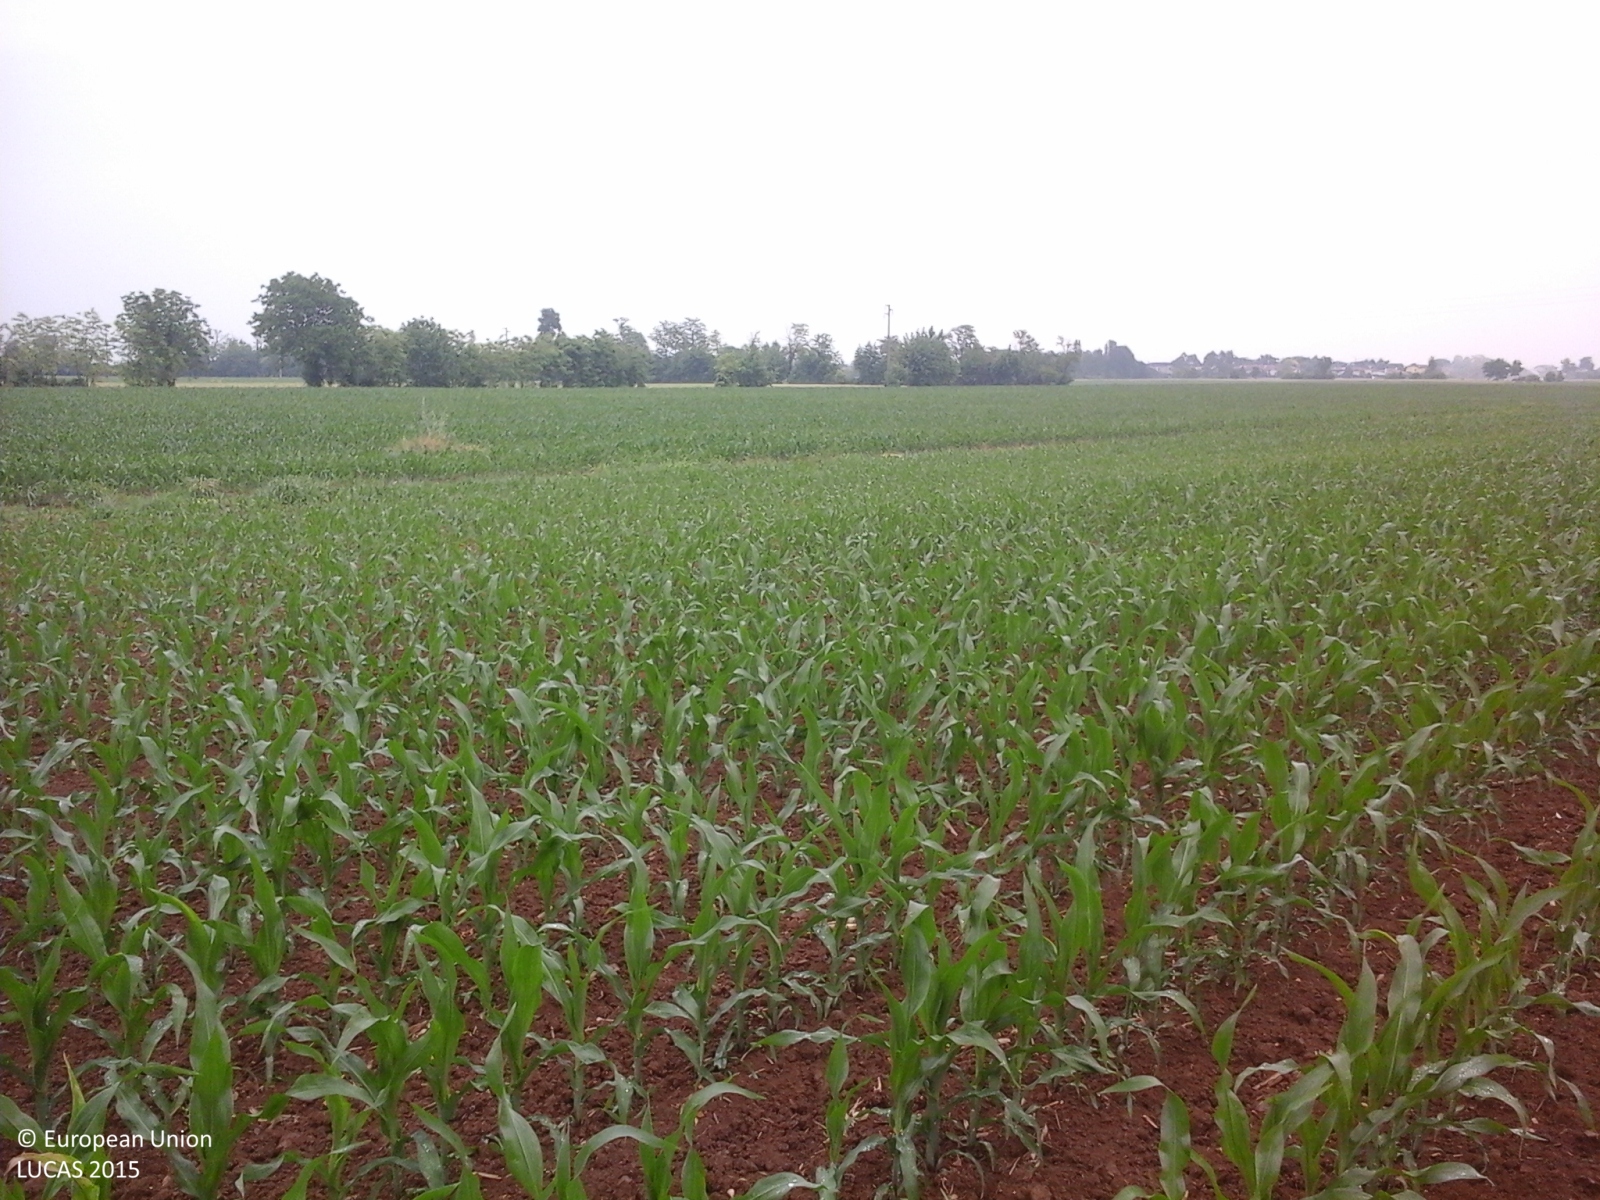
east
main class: Cropland
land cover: Maize
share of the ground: 25 - 50 %
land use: Agriculture (excluding fallow land and kitchen gardens)
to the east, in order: Maize
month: May
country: IT
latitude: 45.1232
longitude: 10.7487
